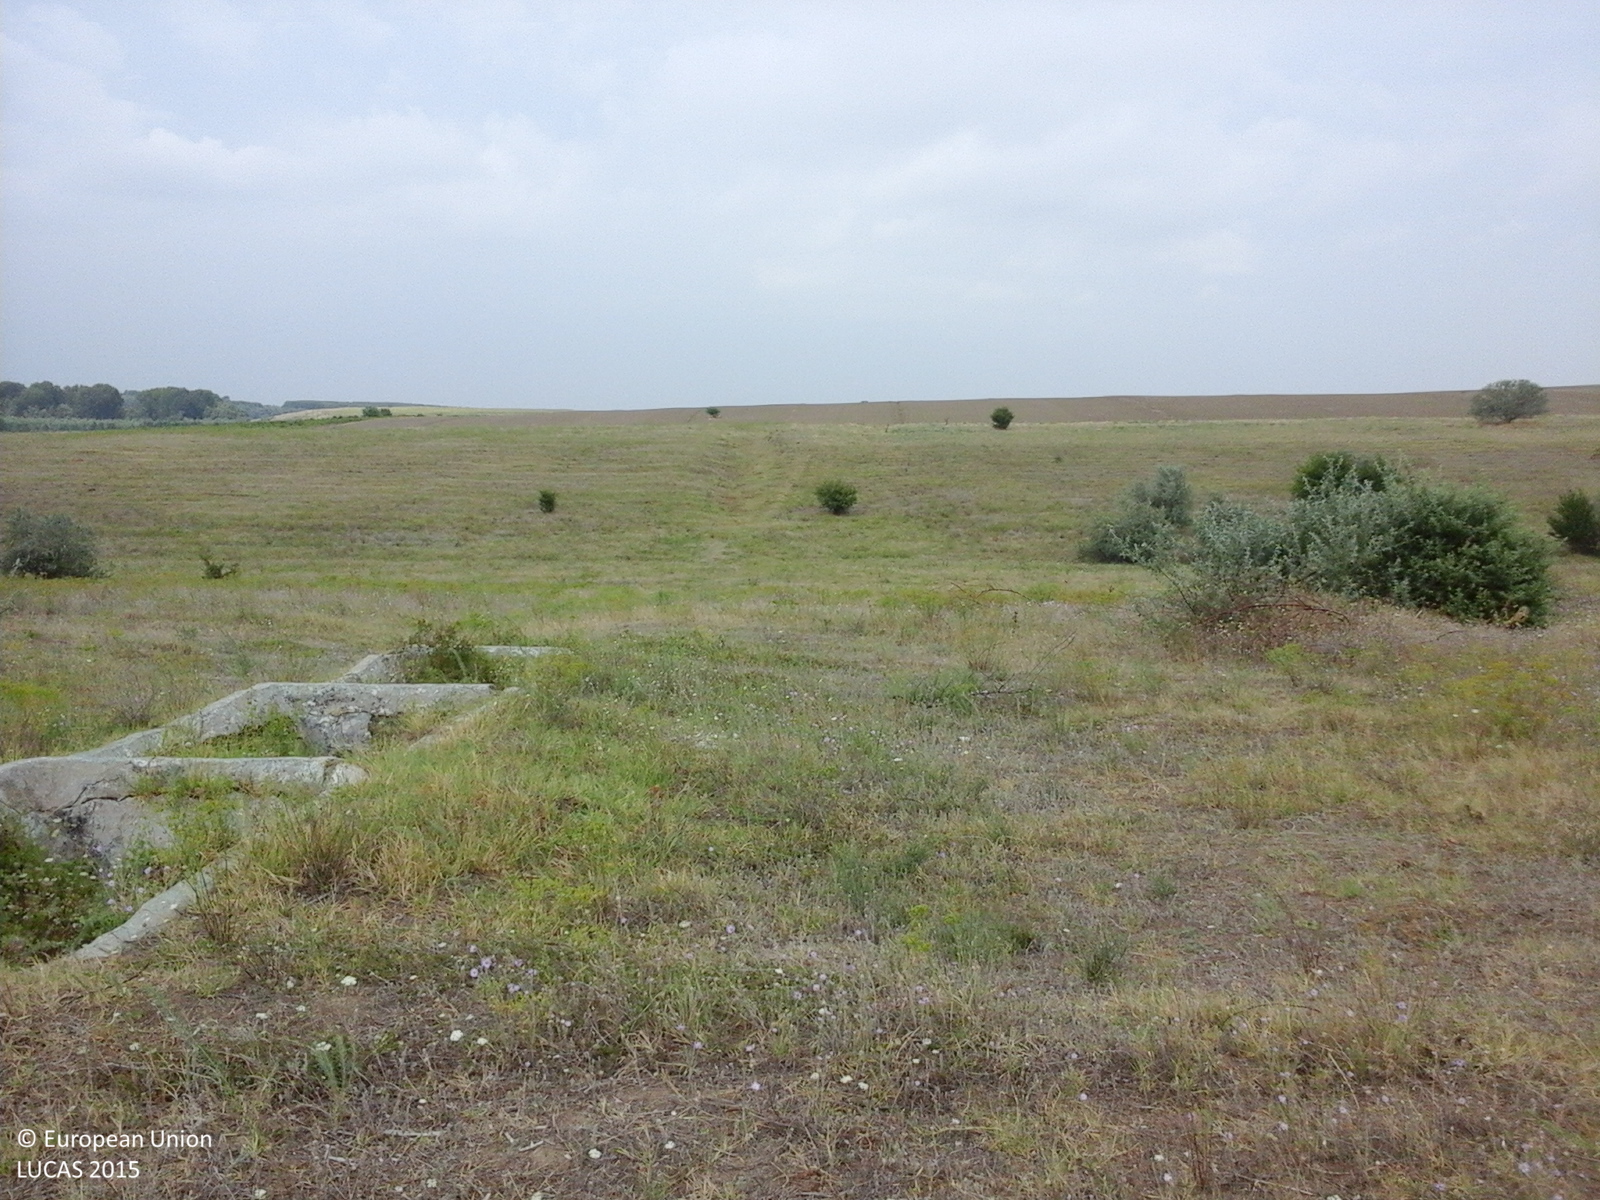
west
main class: Grassland
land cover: Grassland without tree/shrub cover
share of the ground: > 75 %
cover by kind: herbaceous plants 100 %
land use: Agriculture (excluding fallow land and kitchen gardens)
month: July
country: RO
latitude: 44.9818
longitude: 28.1641
